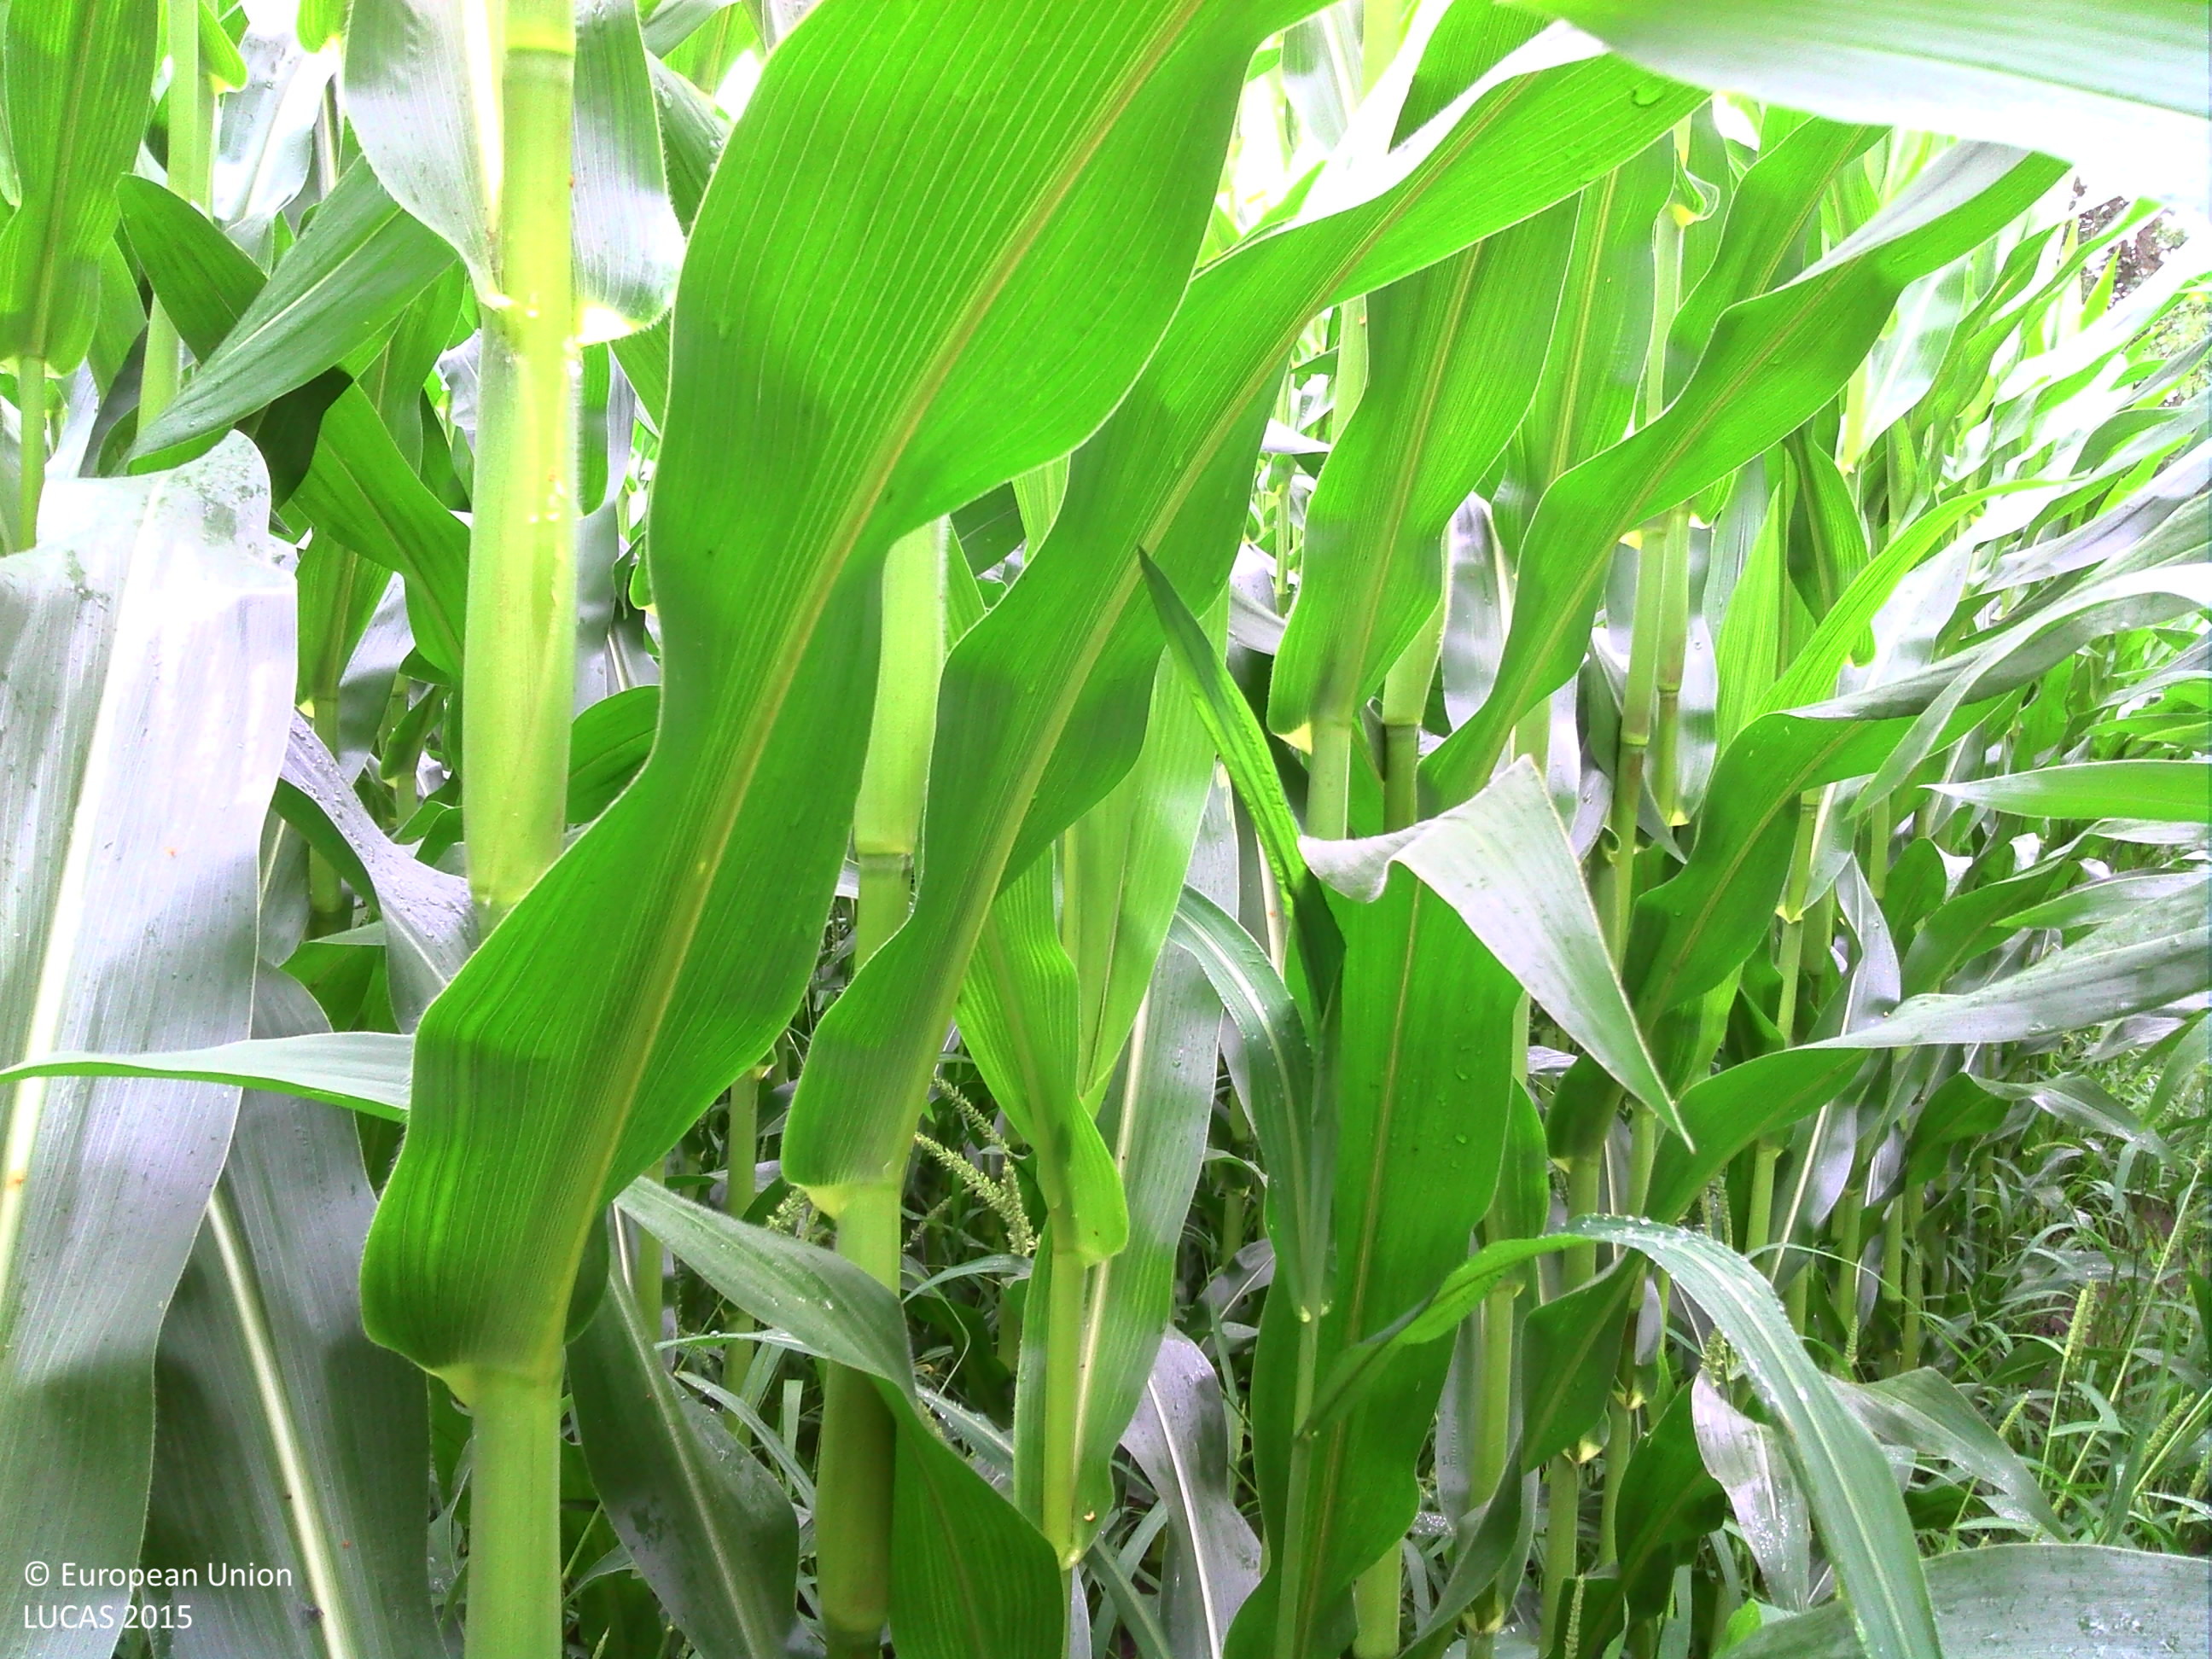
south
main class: Cropland
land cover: Maize
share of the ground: > 75 %
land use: Agriculture (excluding fallow land and kitchen gardens)
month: July
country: BE
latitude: 50.9044
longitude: 5.4618
